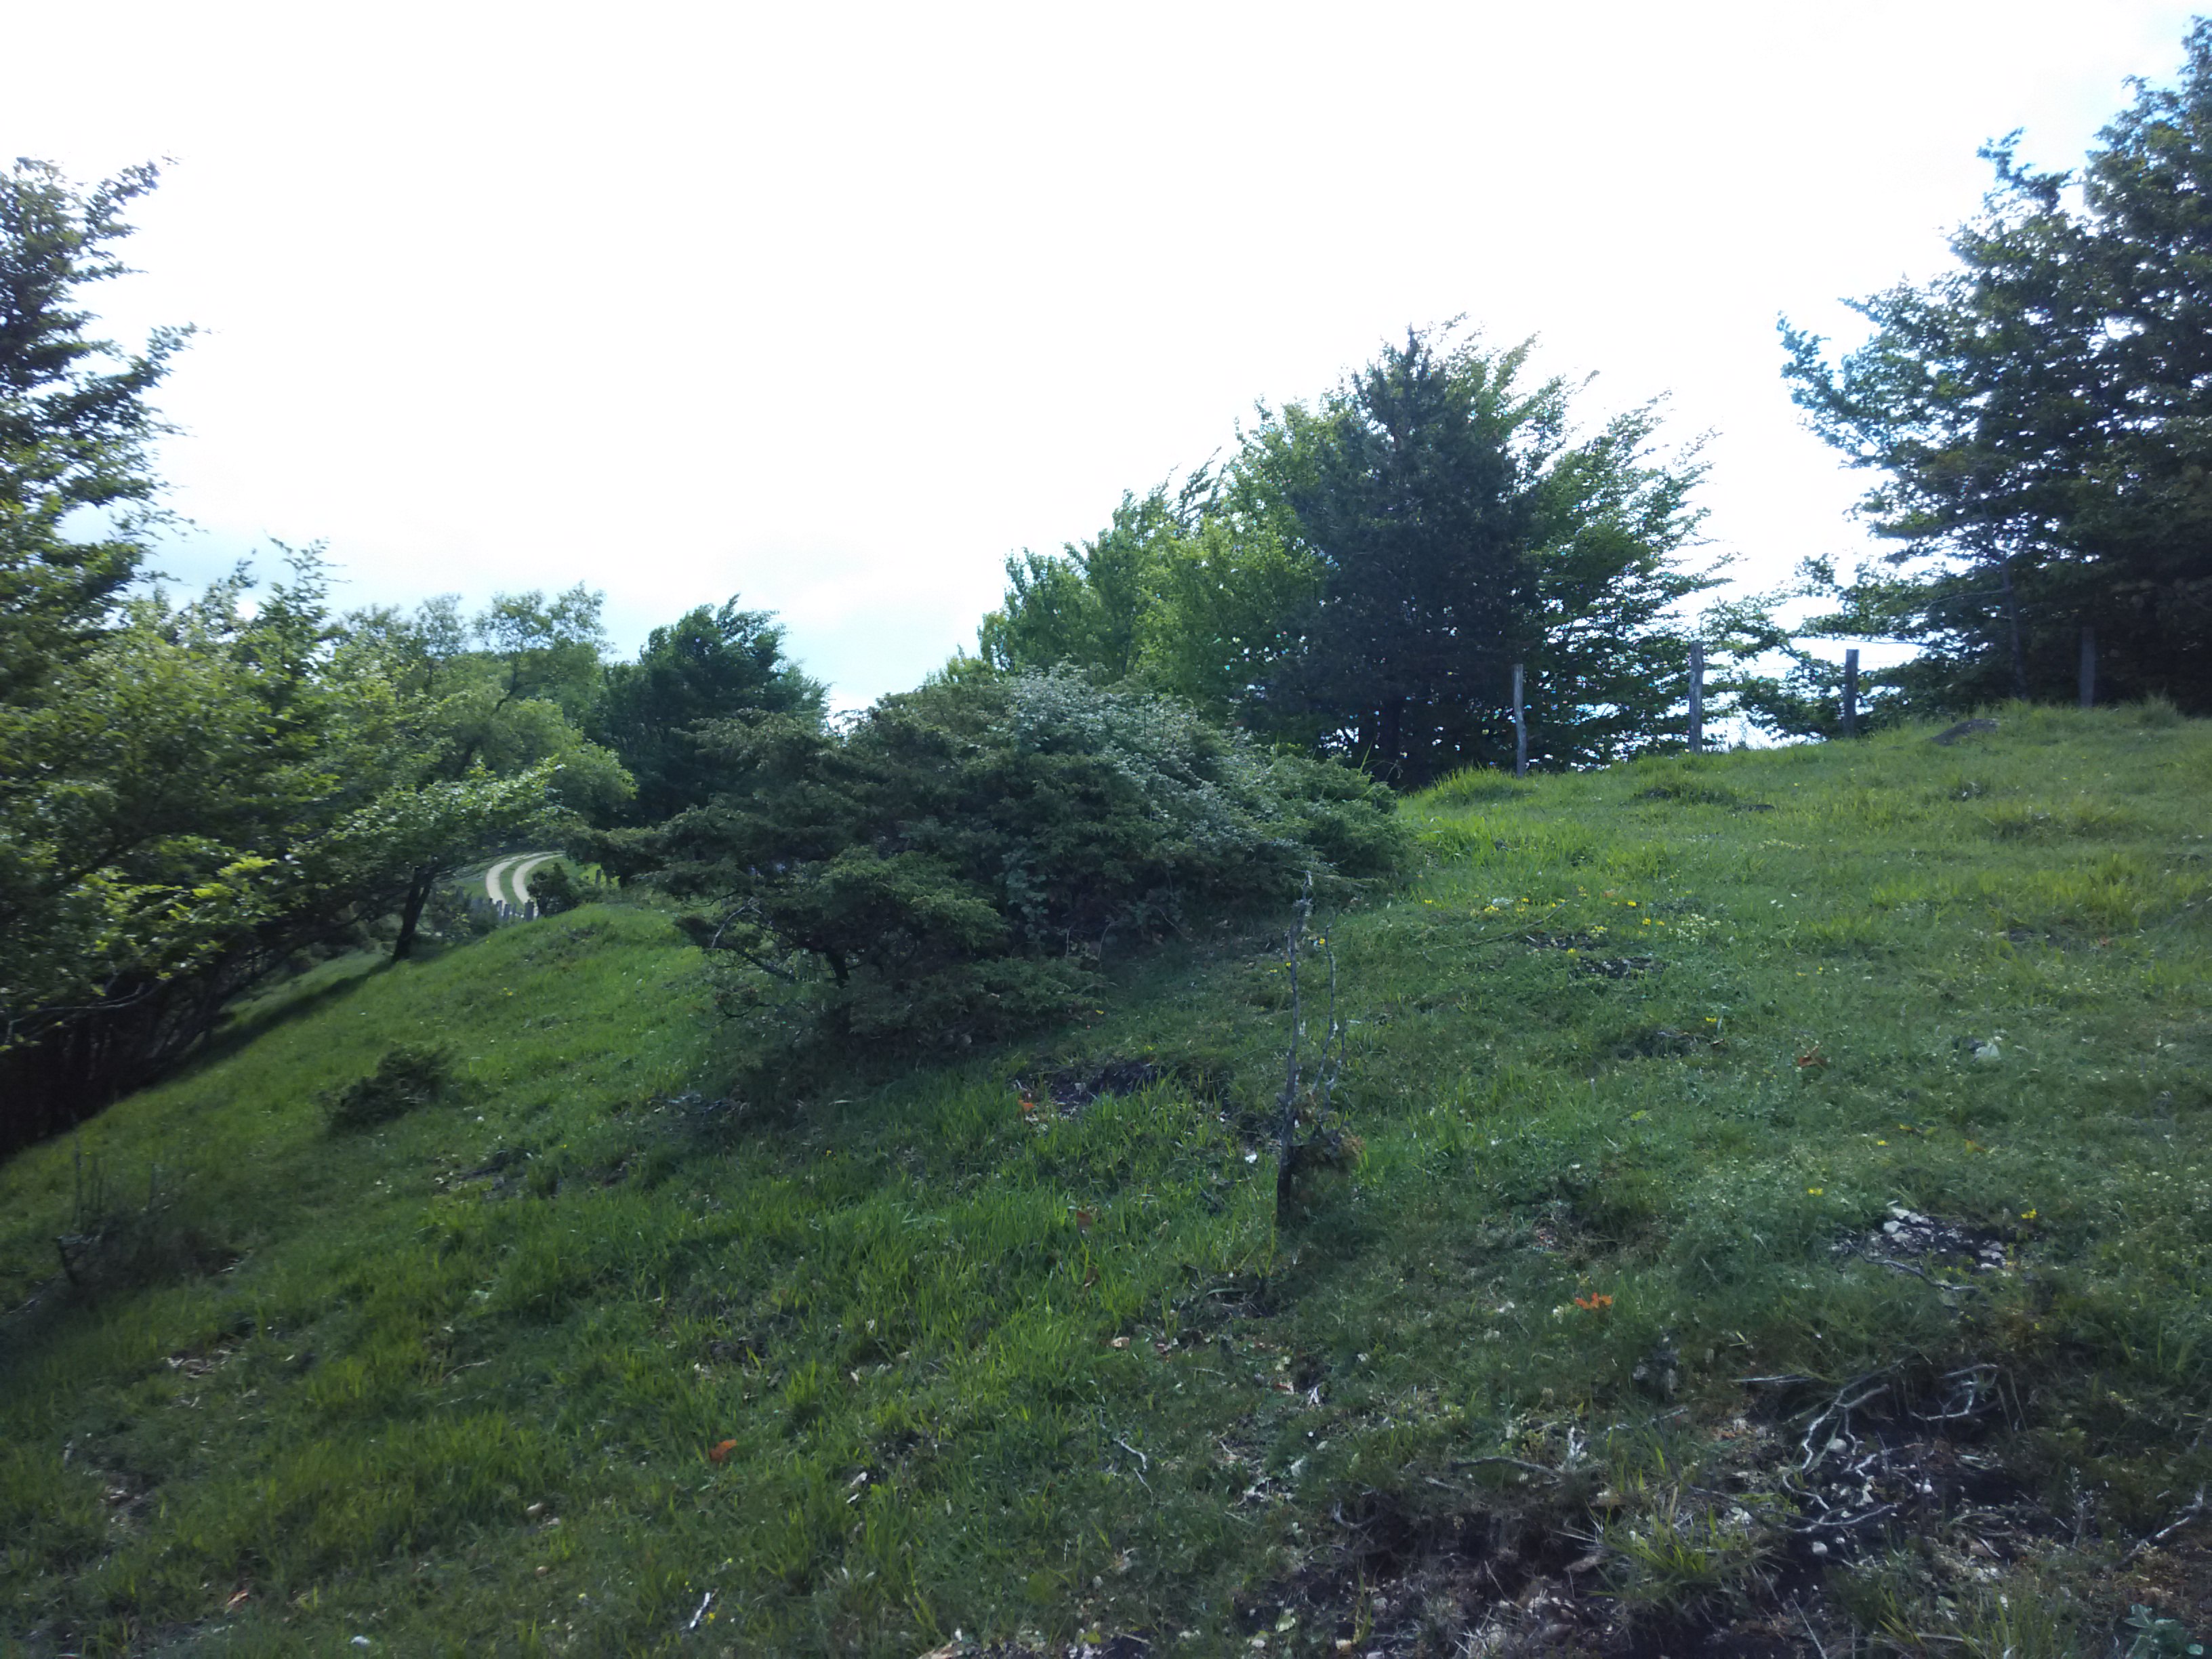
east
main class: Woodland
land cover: Broadleaved woodland
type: beech forest
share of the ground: > 75 %
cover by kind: broadleaved forest trees 70 %, coniferous forest trees 20 %, shrubs 5 %, herbaceous plants 5 %
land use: Forestry
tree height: > 5 m
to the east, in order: Broadleaved woodland; Tracks; Broadleaved woodland
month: May
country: ES
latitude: 42.7971
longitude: -2.4333
